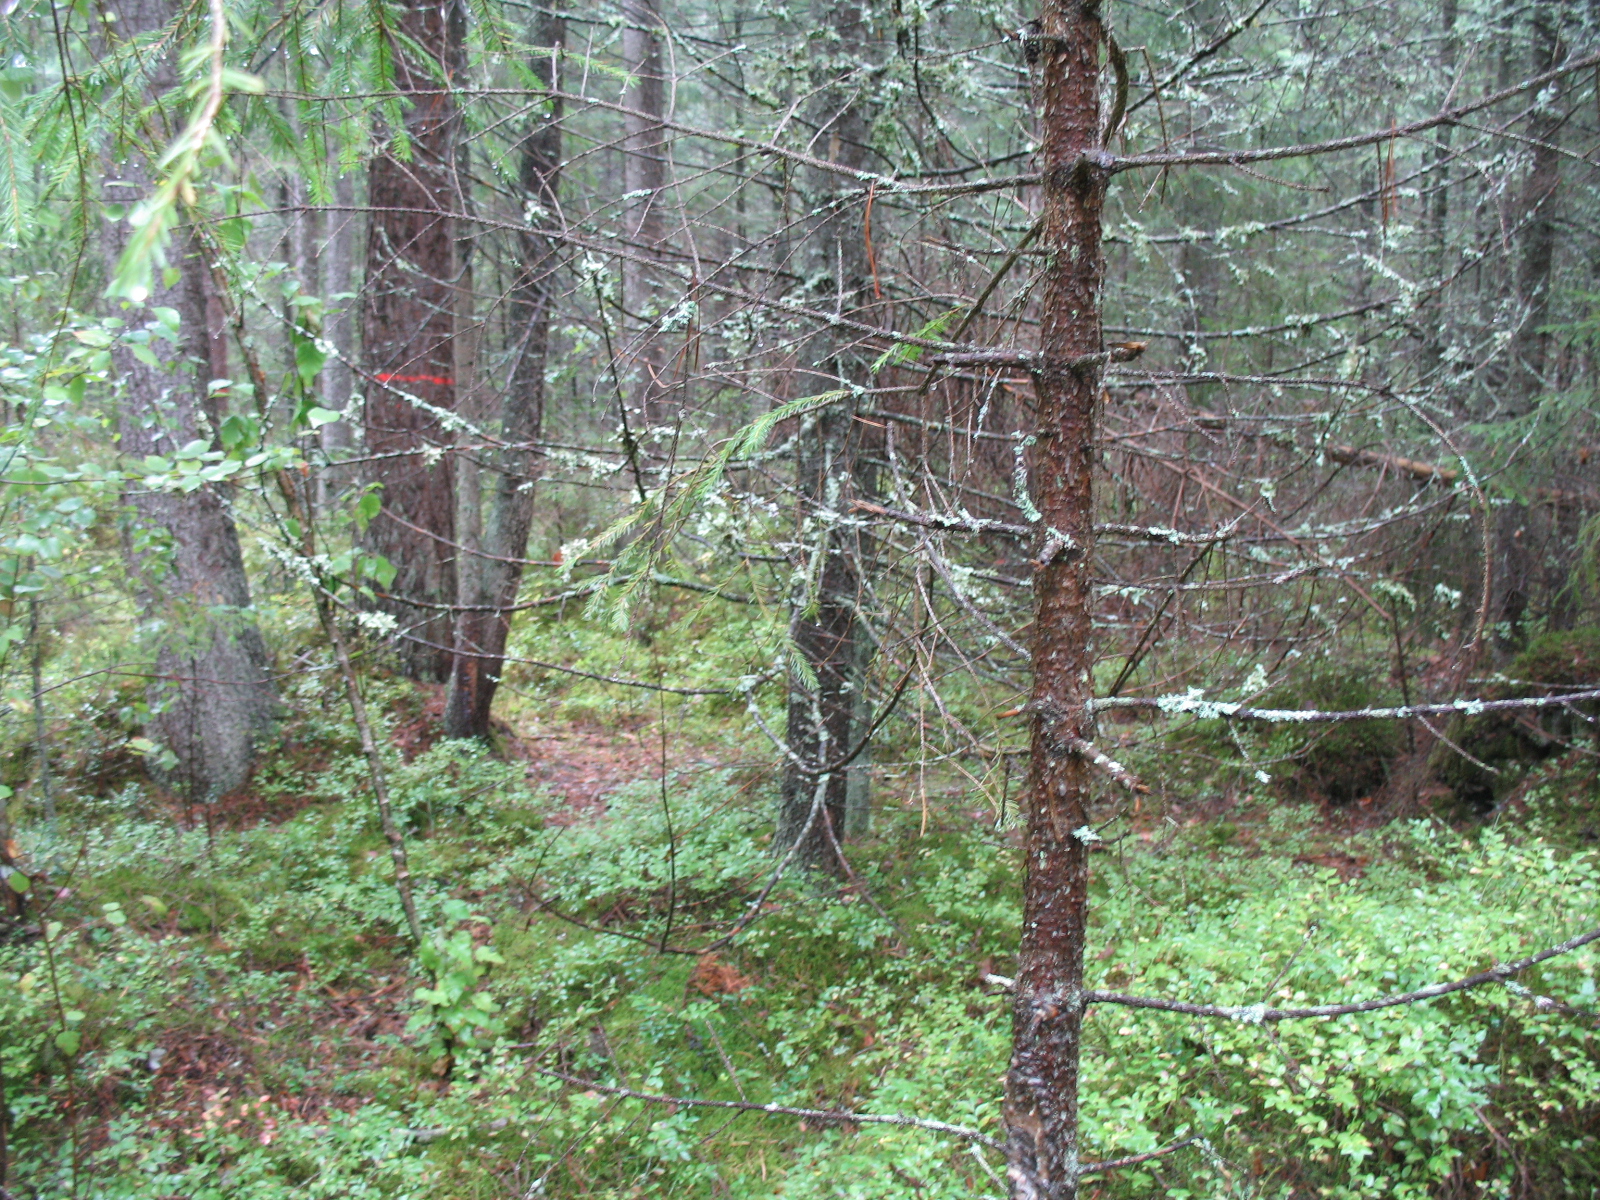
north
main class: Woodland
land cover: Other coniferous woodland
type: hemiboreal forest and nemoral coniferous forest and mixed broadleaved-coniferous forest
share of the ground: > 75 %
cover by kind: coniferous forest trees 75 %, herbaceous plants 10 %, lichens and mosses 10 %, shrubs 5 %
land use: Forestry
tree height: > 5 m
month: September
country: LV
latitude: 56.1305
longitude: 26.2805
